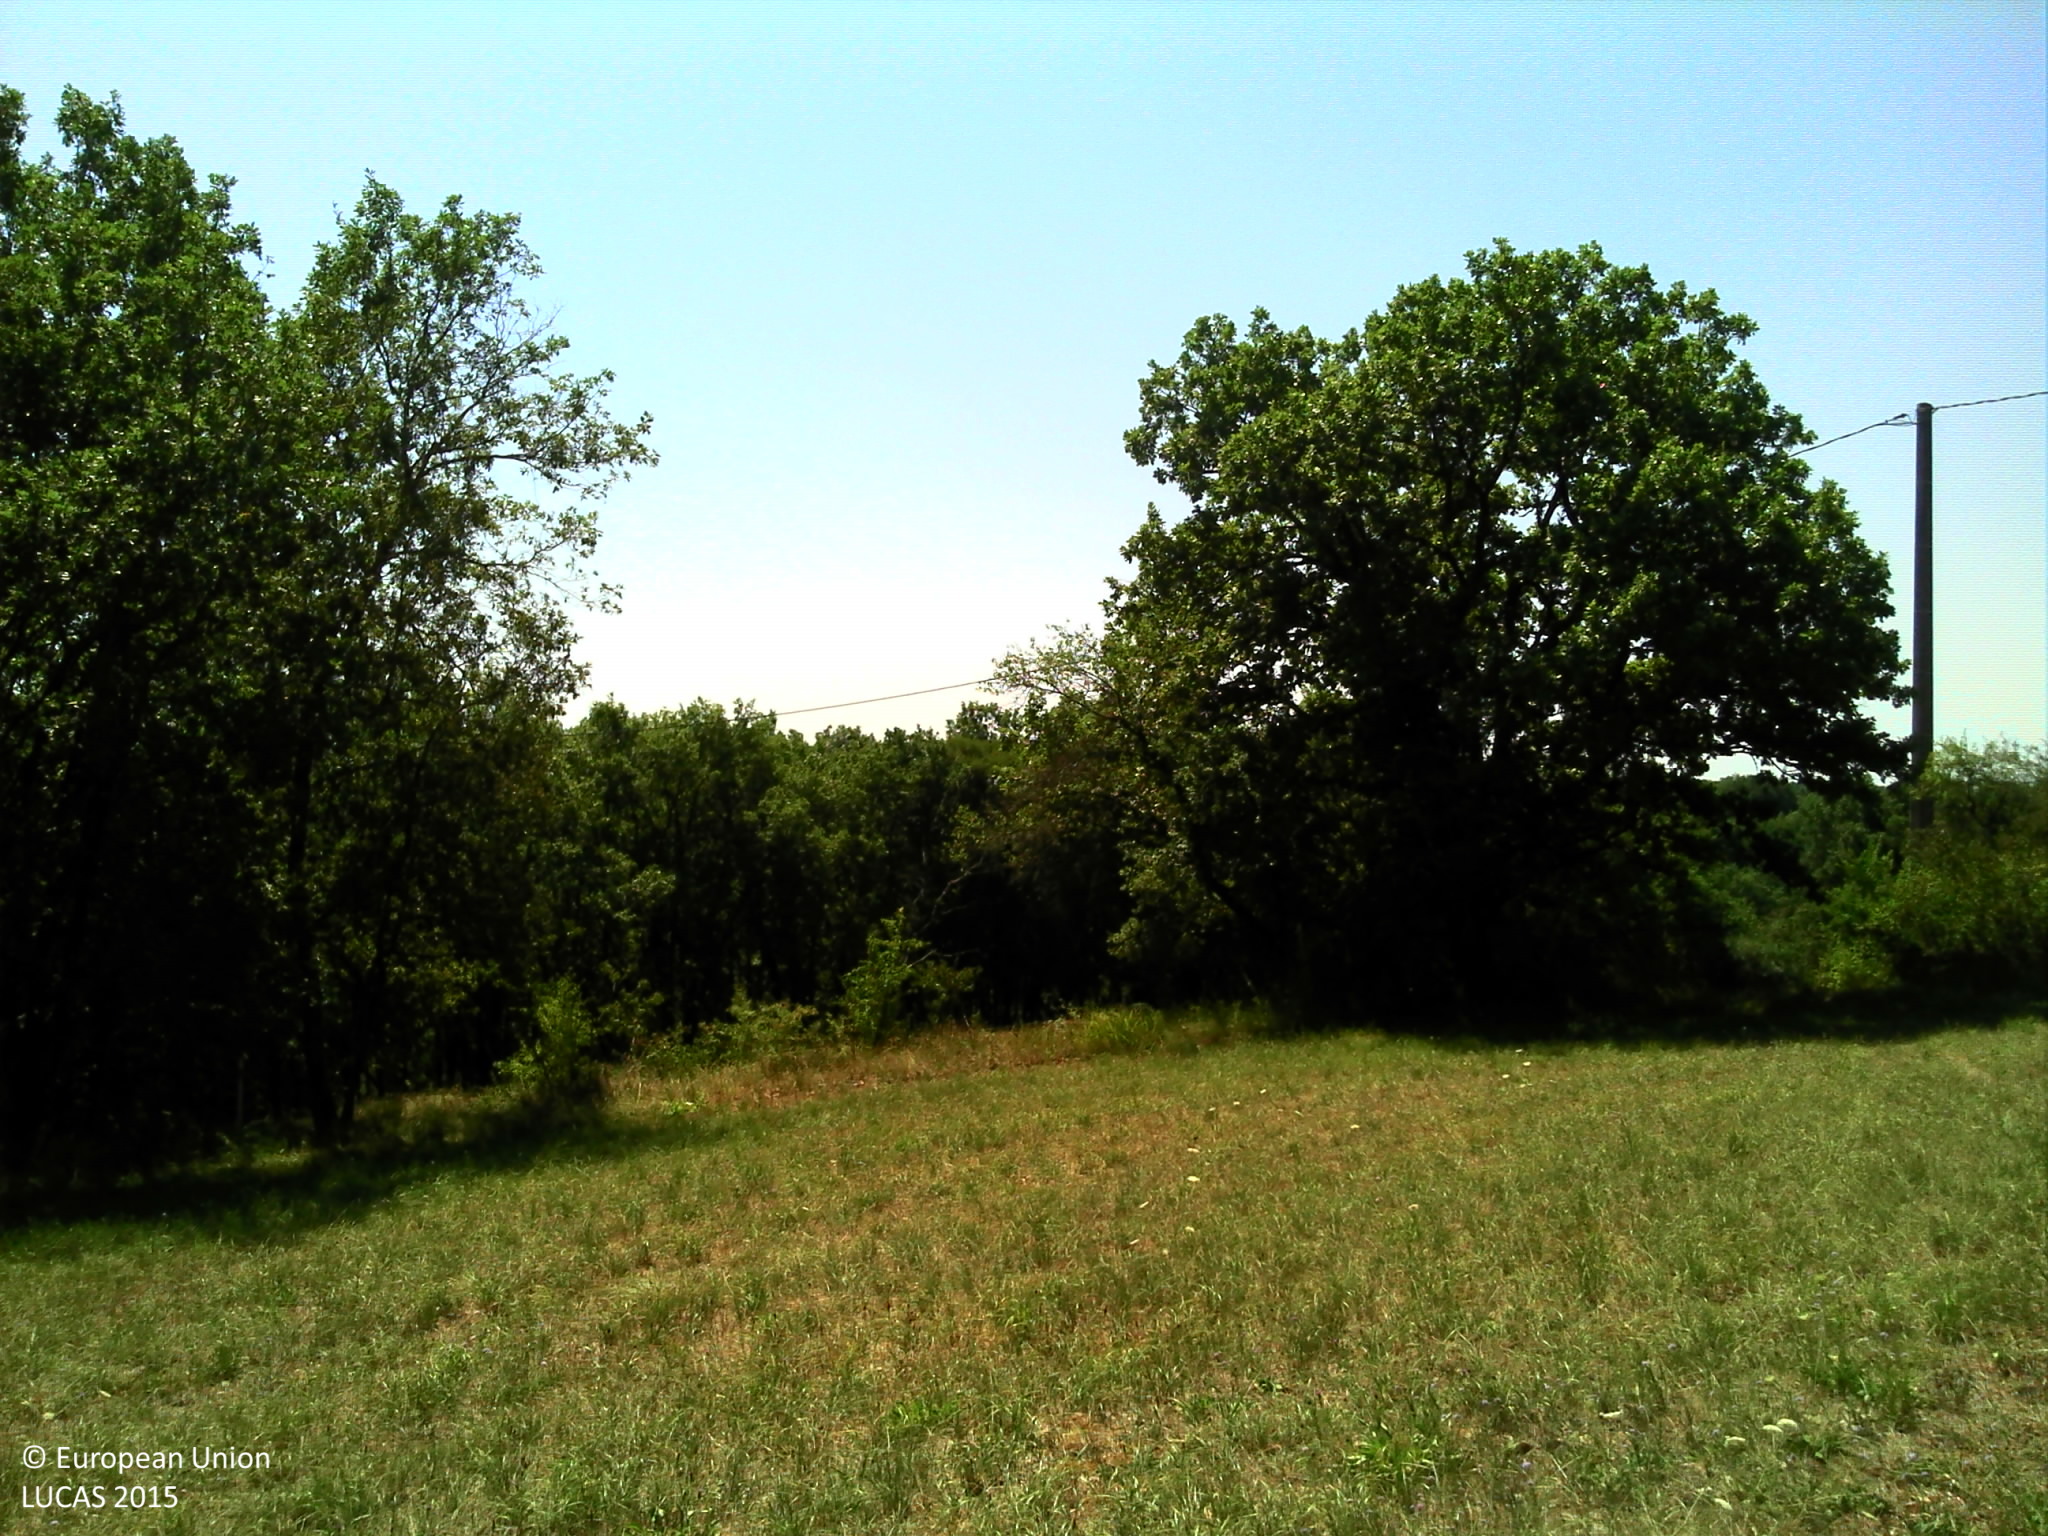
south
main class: Grassland
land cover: Grassland without tree/shrub cover
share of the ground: > 75 %
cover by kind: herbaceous plants 100 %
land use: Agriculture (excluding fallow land and kitchen gardens)
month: August
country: FR
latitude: 44.7604
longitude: 0.8339
